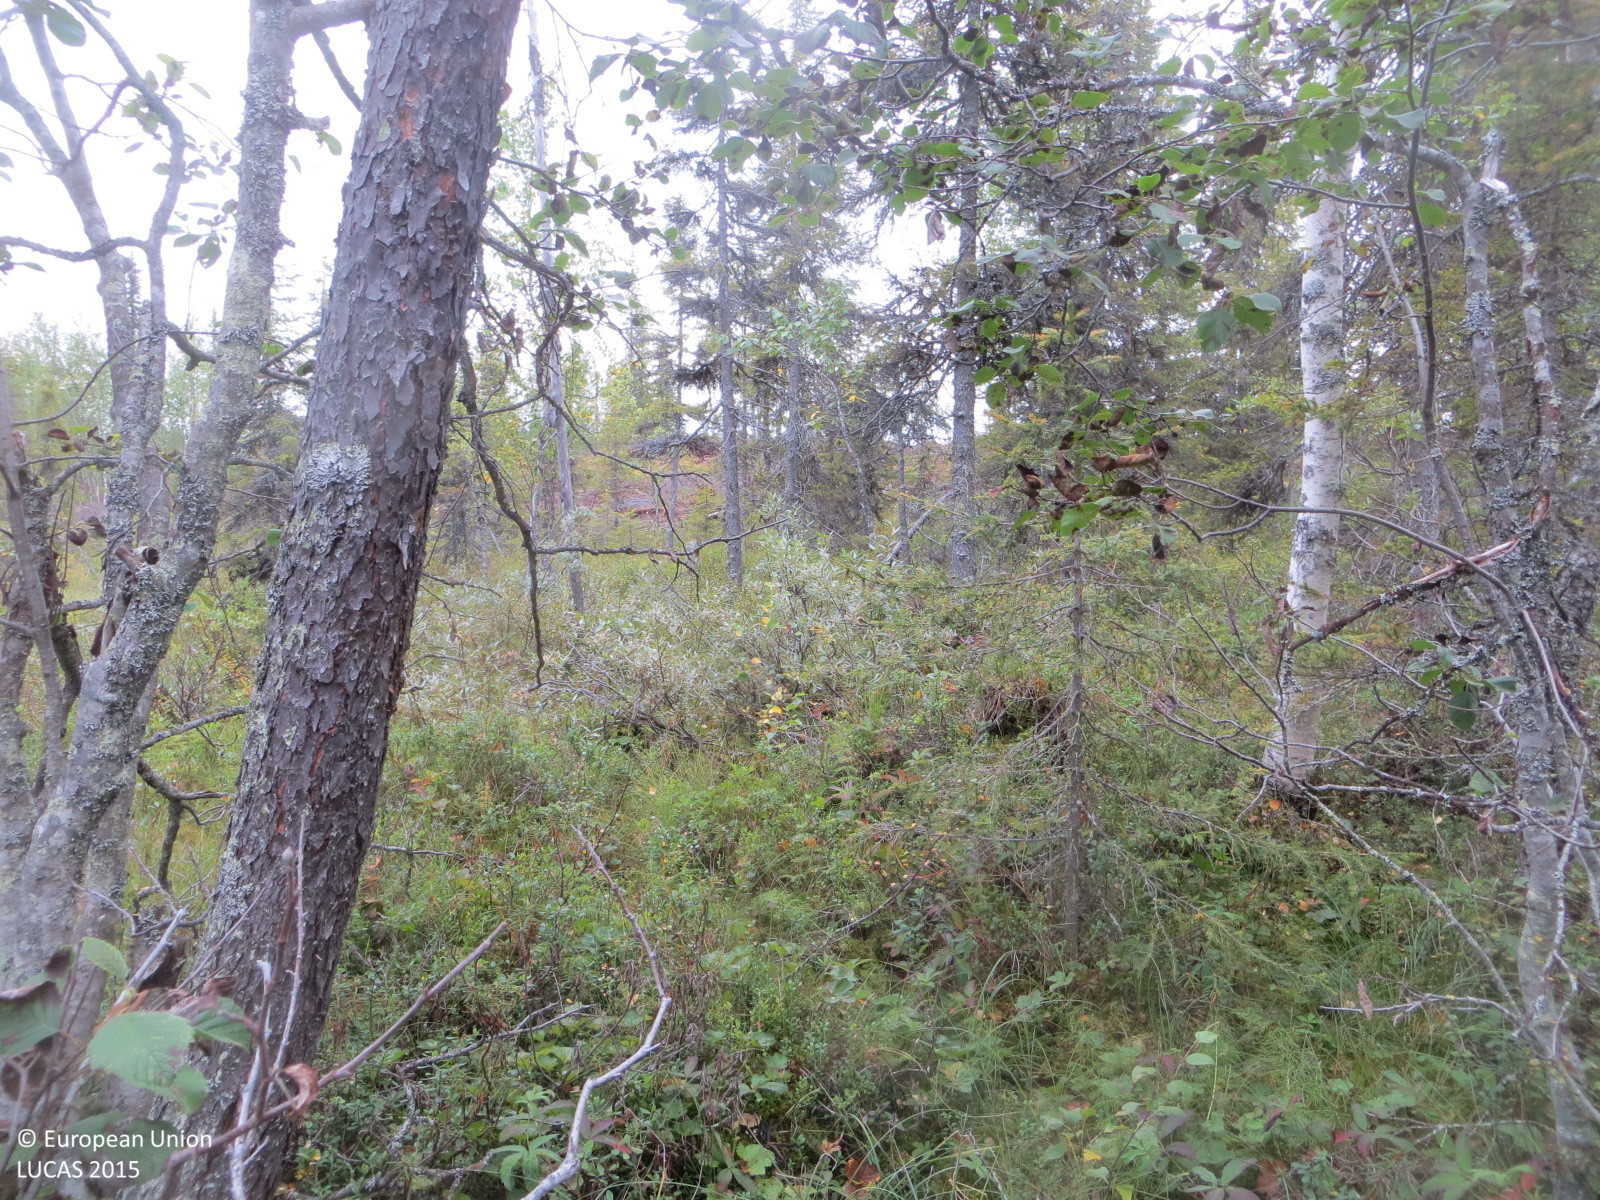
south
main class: Woodland
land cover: Spruce dominated mixed woodland
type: mire and swamp forests
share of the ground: 50 - 75 %
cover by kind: coniferous forest trees 35 %, broadleaved forest trees 35 %, herbaceous plants 20 %, shrubs 10 %
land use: Forestry
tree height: > 5 m
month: August
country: FI
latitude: 67.4978
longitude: 24.2390
